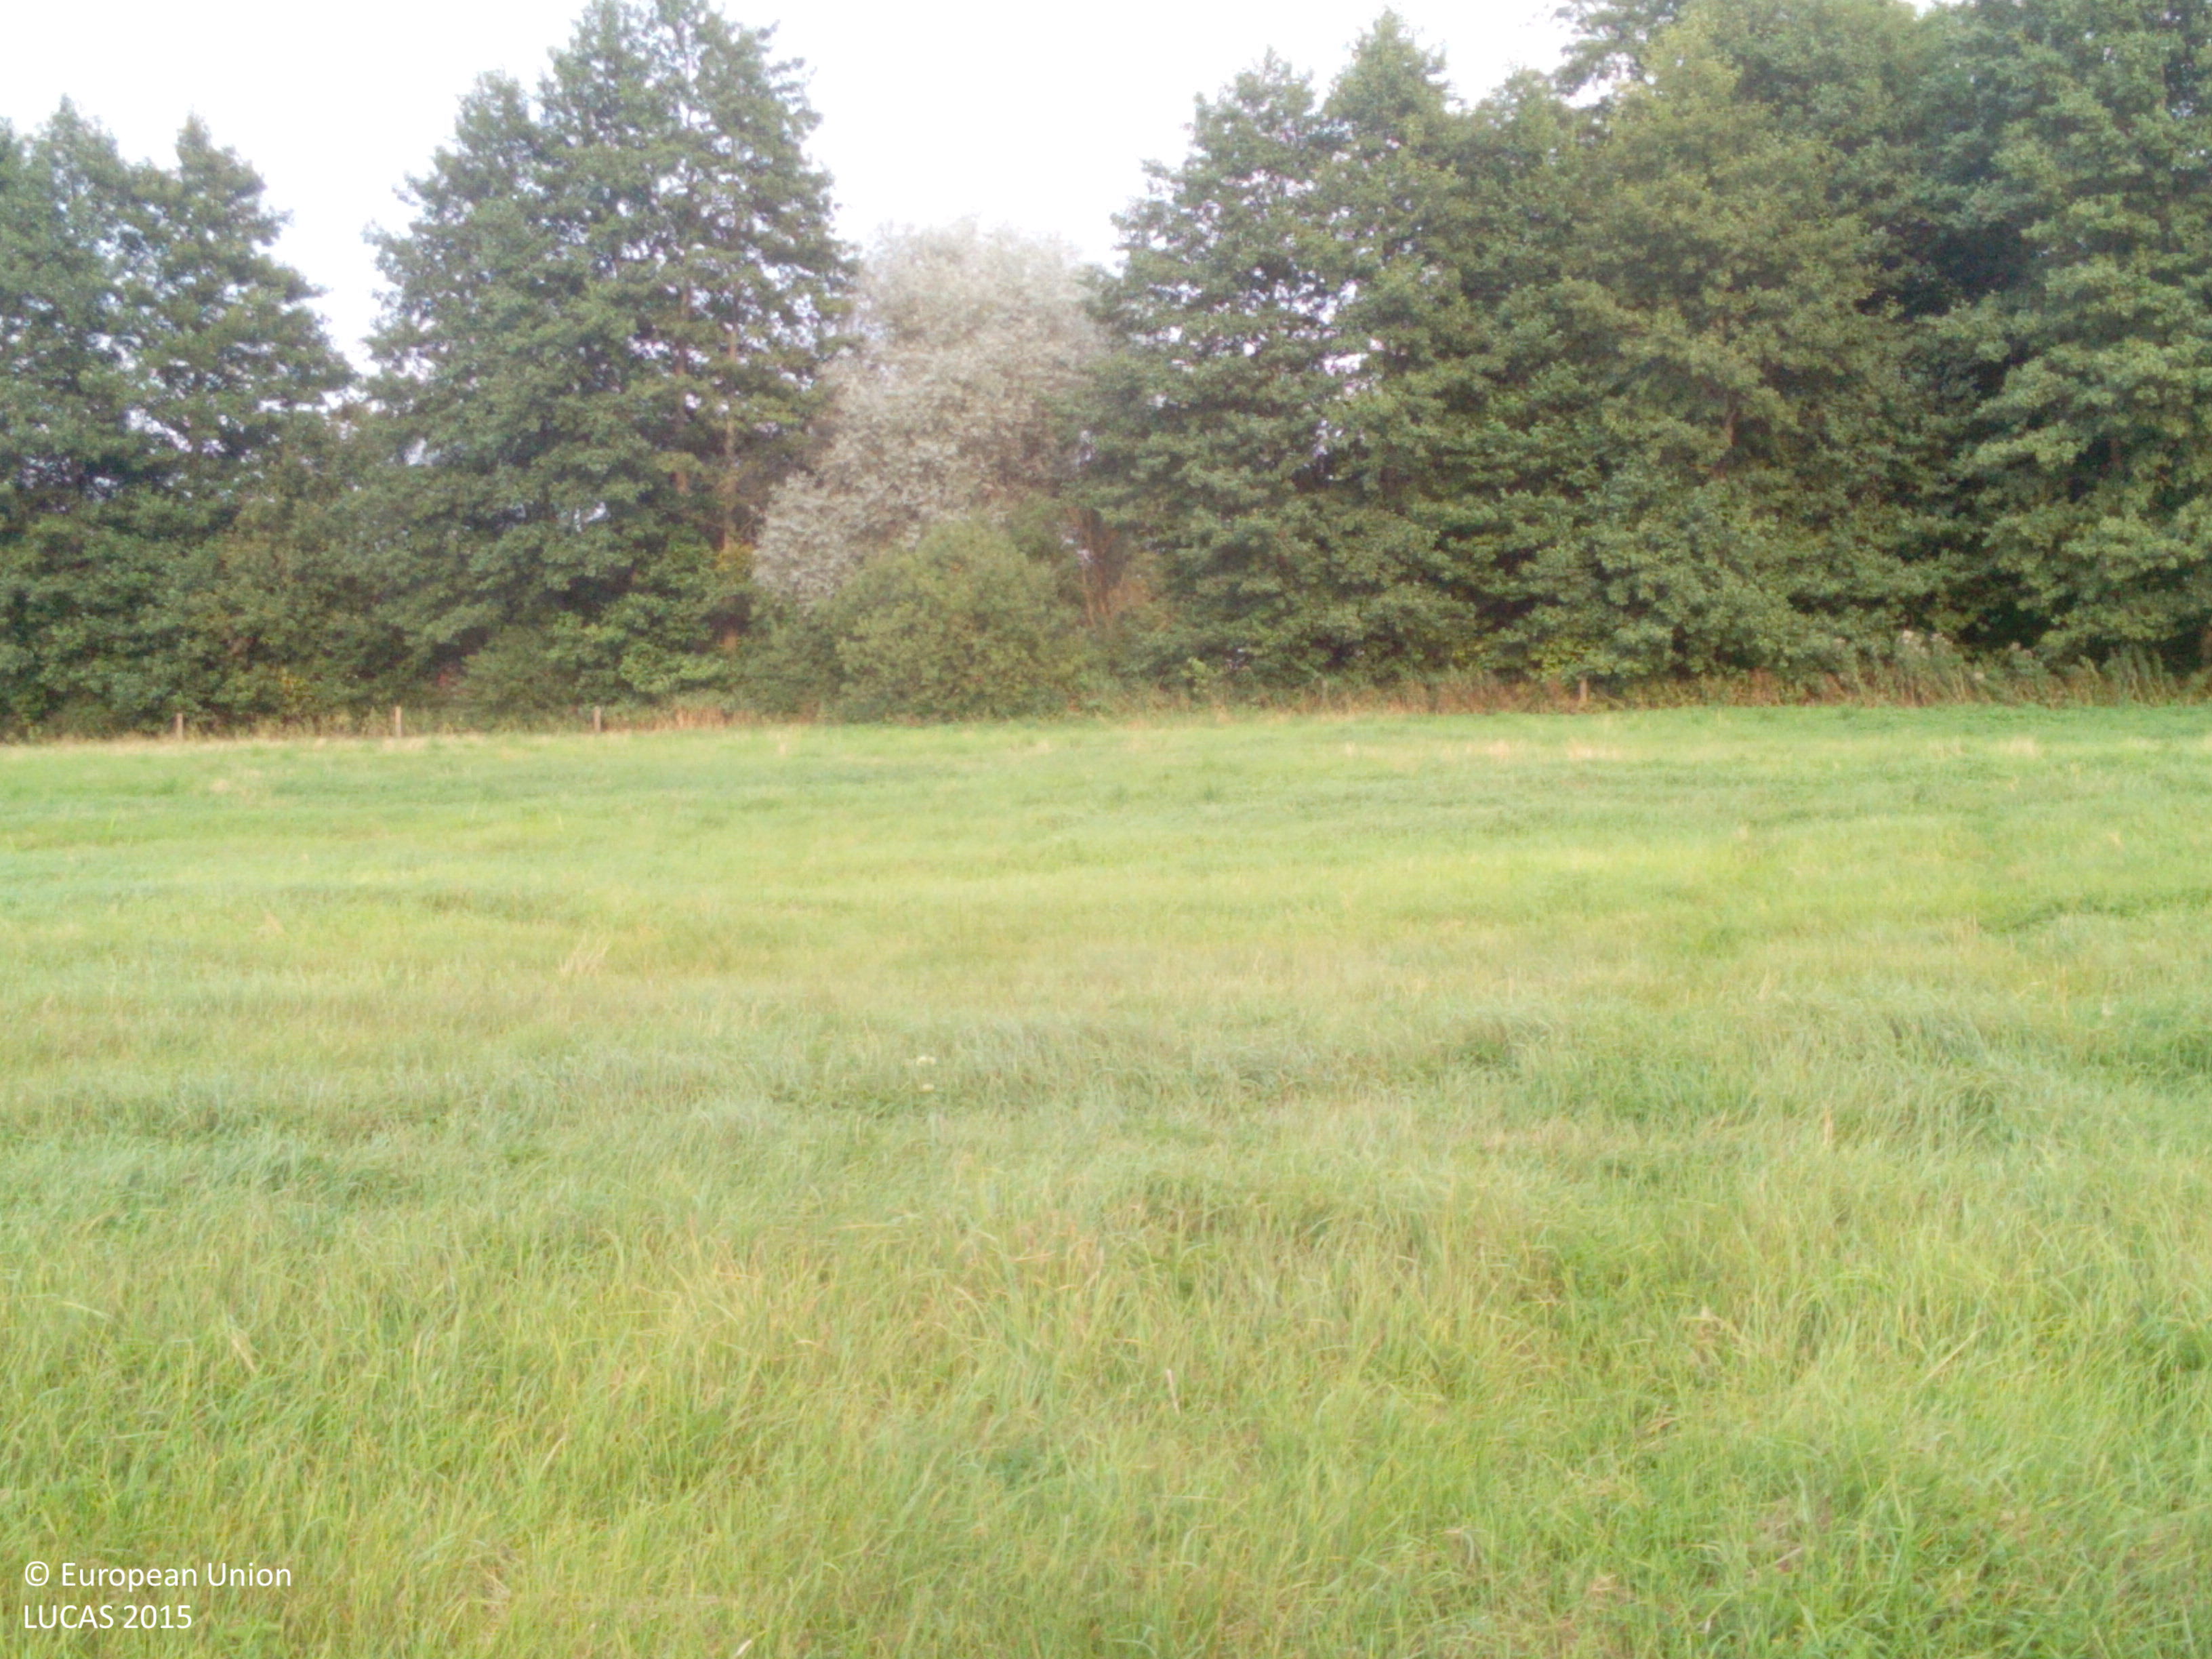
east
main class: Grassland
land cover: Grassland without tree/shrub cover
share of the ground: > 75 %
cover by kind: herbaceous plants 100 %
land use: Agriculture (excluding fallow land and kitchen gardens)
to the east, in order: Grassland without tree/shrub cover; Fences; Abandoned hedges; Ditches and canals; Abandoned hedges; Spontaneously vegetated surfaces; Artificial constructions in urban areas; Apple fruit; Grassland without tree/shrub cover; Apple fruit; Common wheat
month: August
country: LV
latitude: 56.1355
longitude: 21.1581
